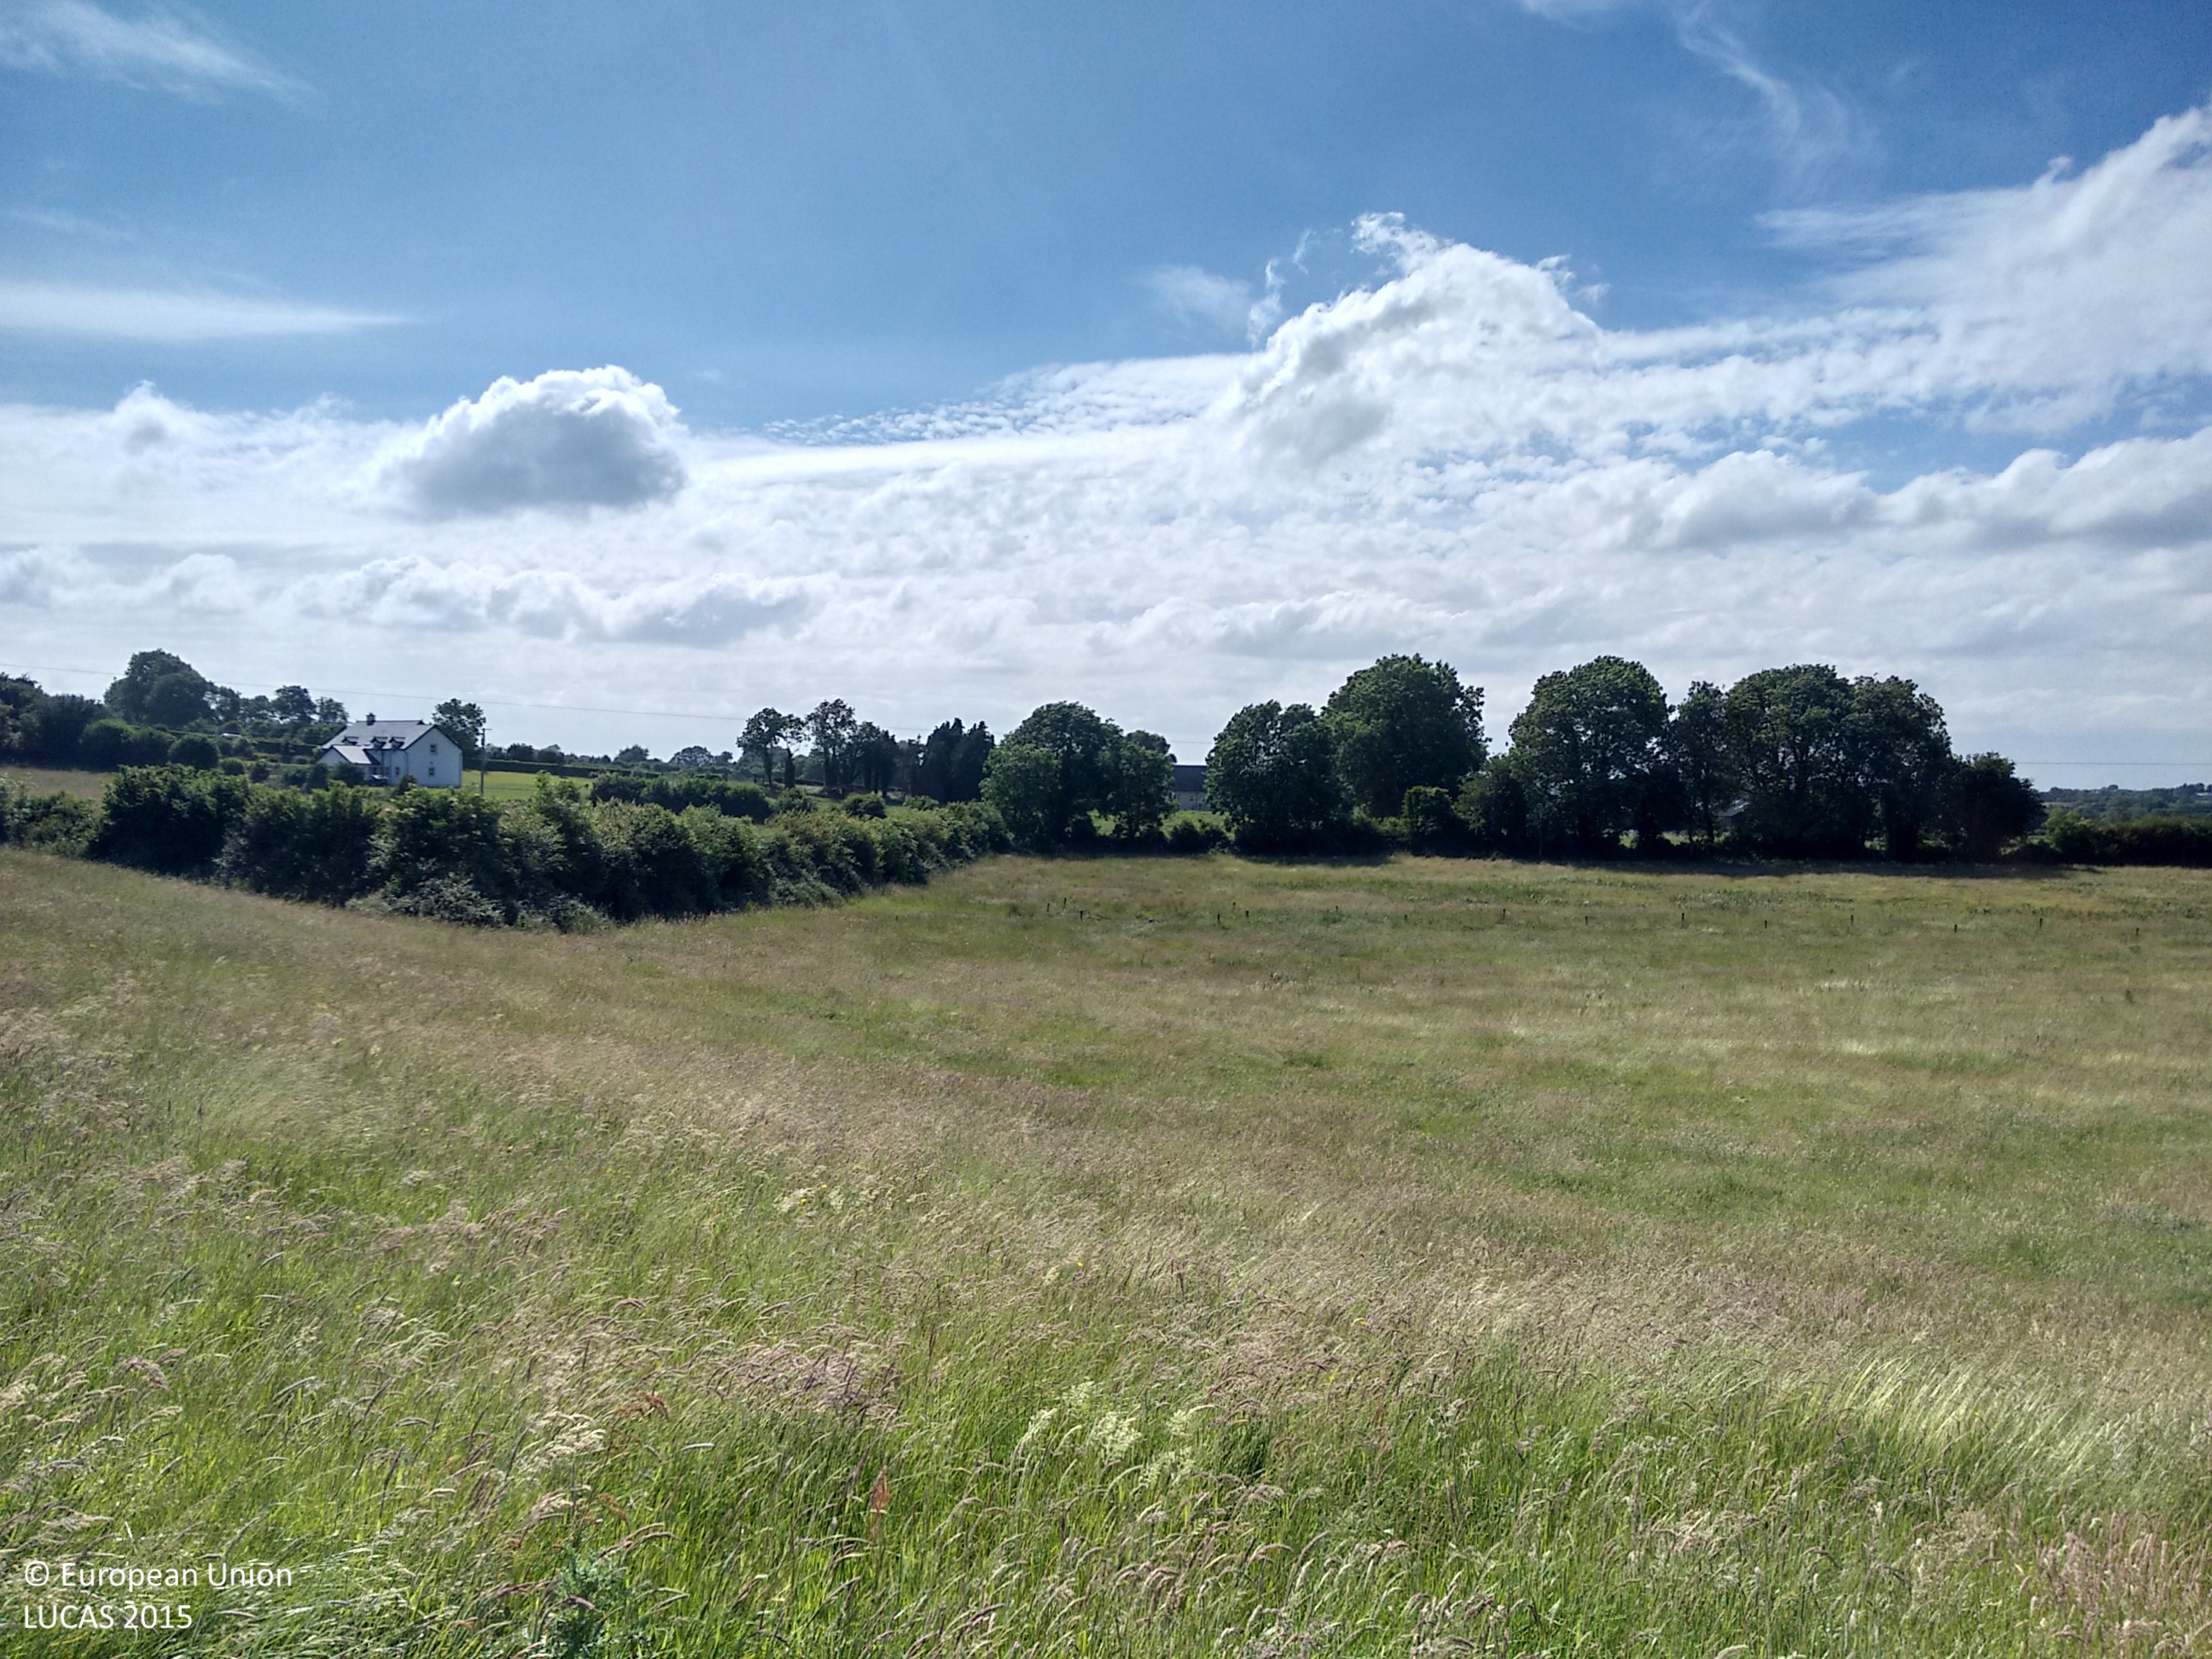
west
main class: Grassland
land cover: Grassland without tree/shrub cover
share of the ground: > 75 %
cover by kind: herbaceous plants 100 %
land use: Agriculture (excluding fallow land and kitchen gardens)
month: June
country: IE
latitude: 53.4374
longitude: -7.7643
